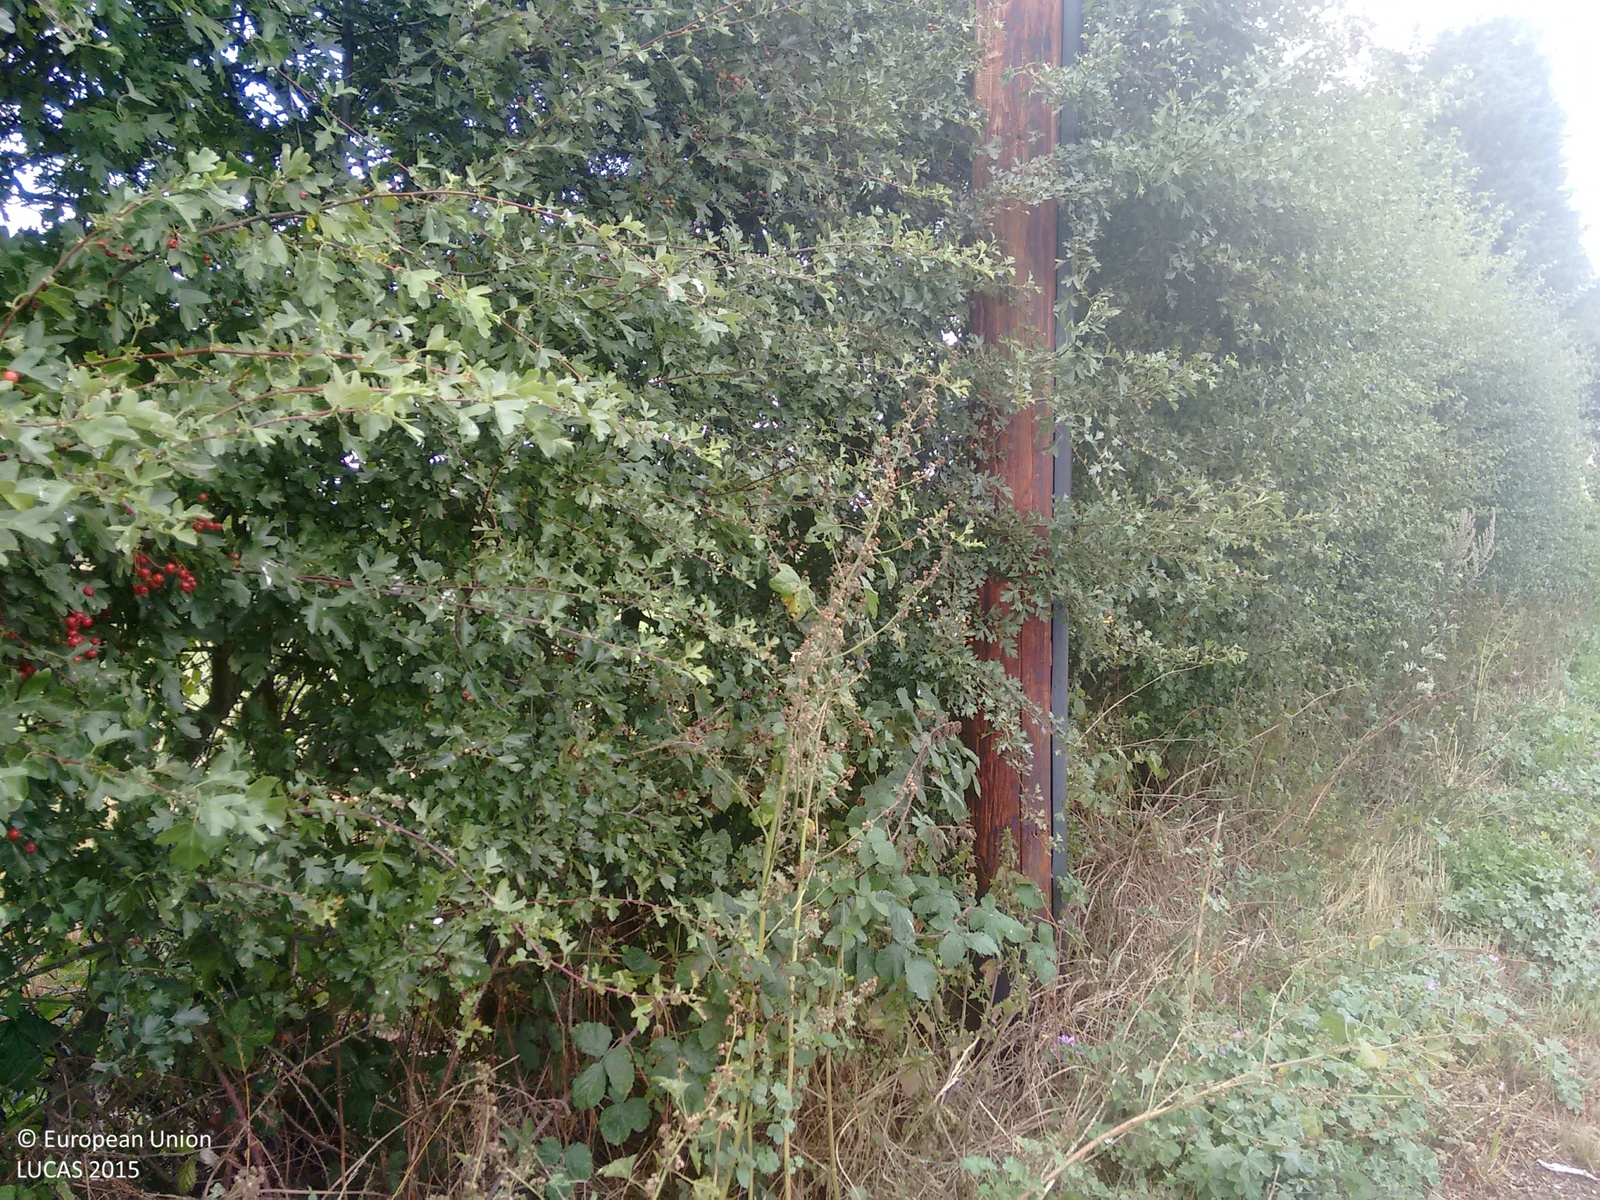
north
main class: Grassland
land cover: Grassland without tree/shrub cover
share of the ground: > 75 %
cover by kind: herbaceous plants 100 %
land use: Agriculture (excluding fallow land and kitchen gardens)
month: August
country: GB
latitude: 51.9246
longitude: 0.9754
